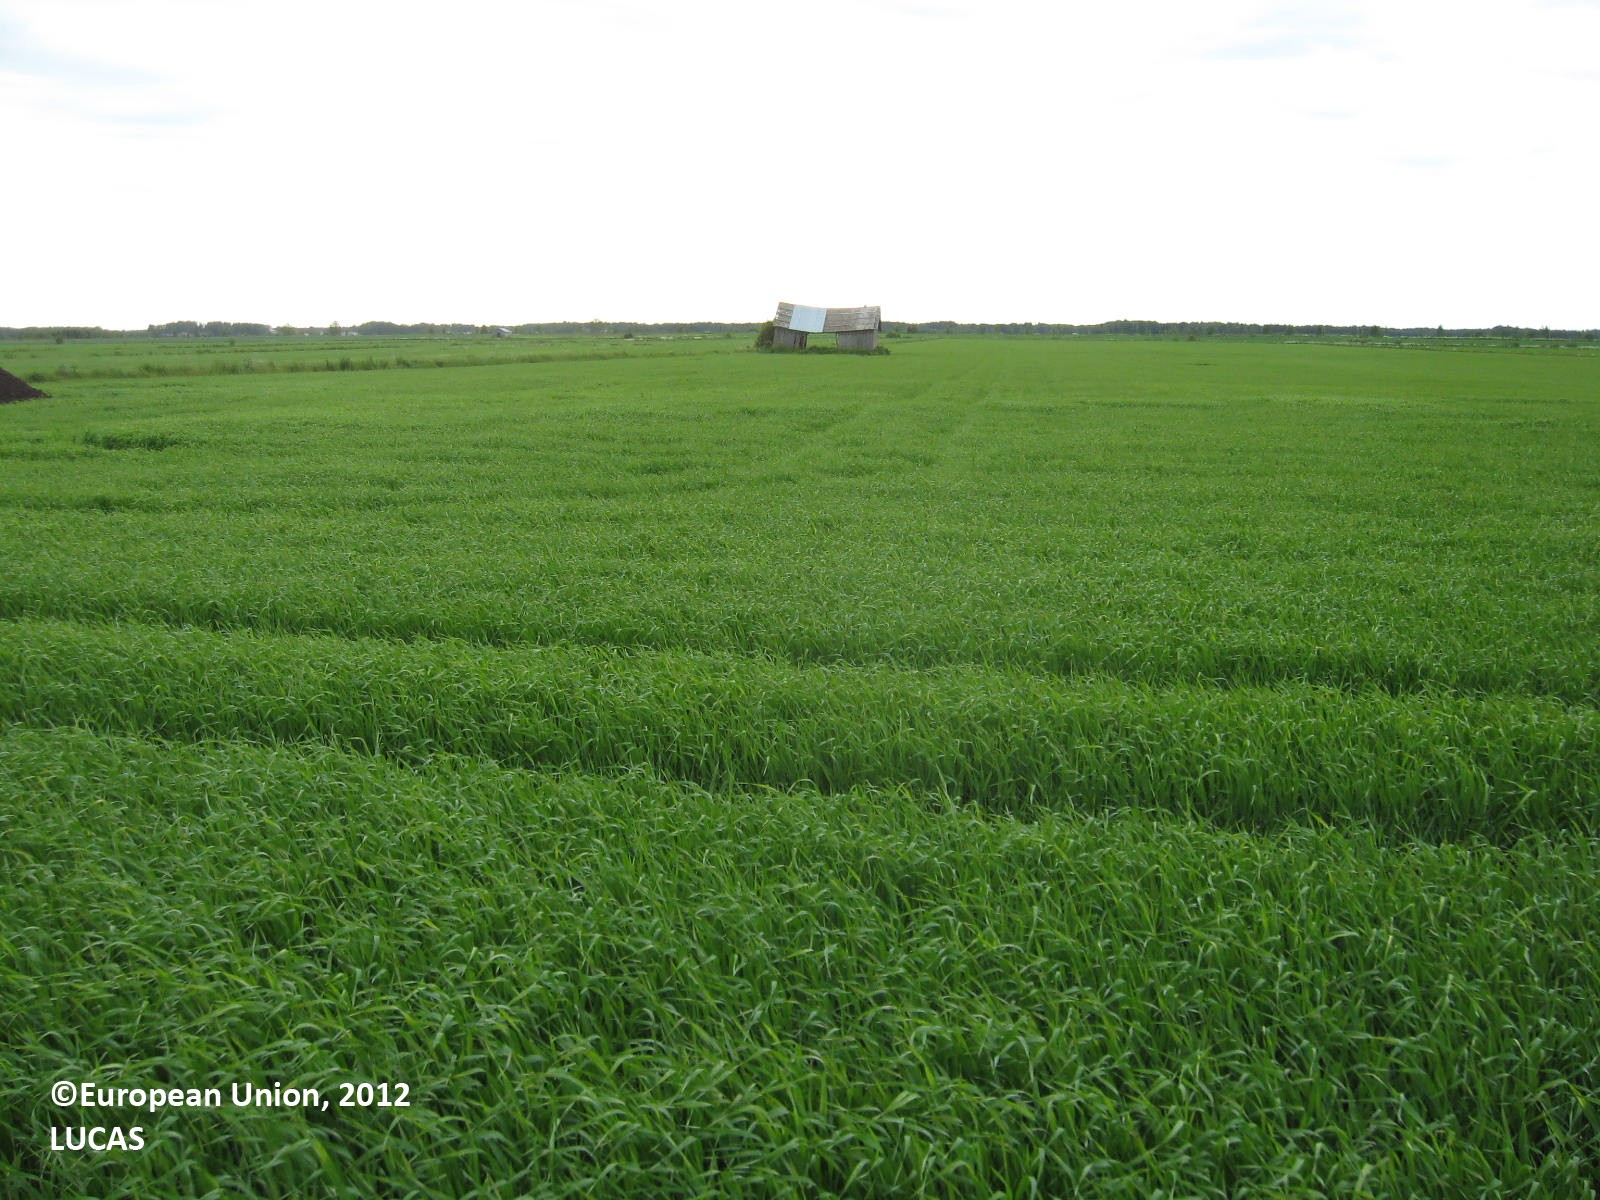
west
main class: Cropland
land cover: Barley
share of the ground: > 75 %
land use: Agriculture (excluding fallow land and kitchen gardens)
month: June
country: FI
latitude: 62.8681
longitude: 22.8132
